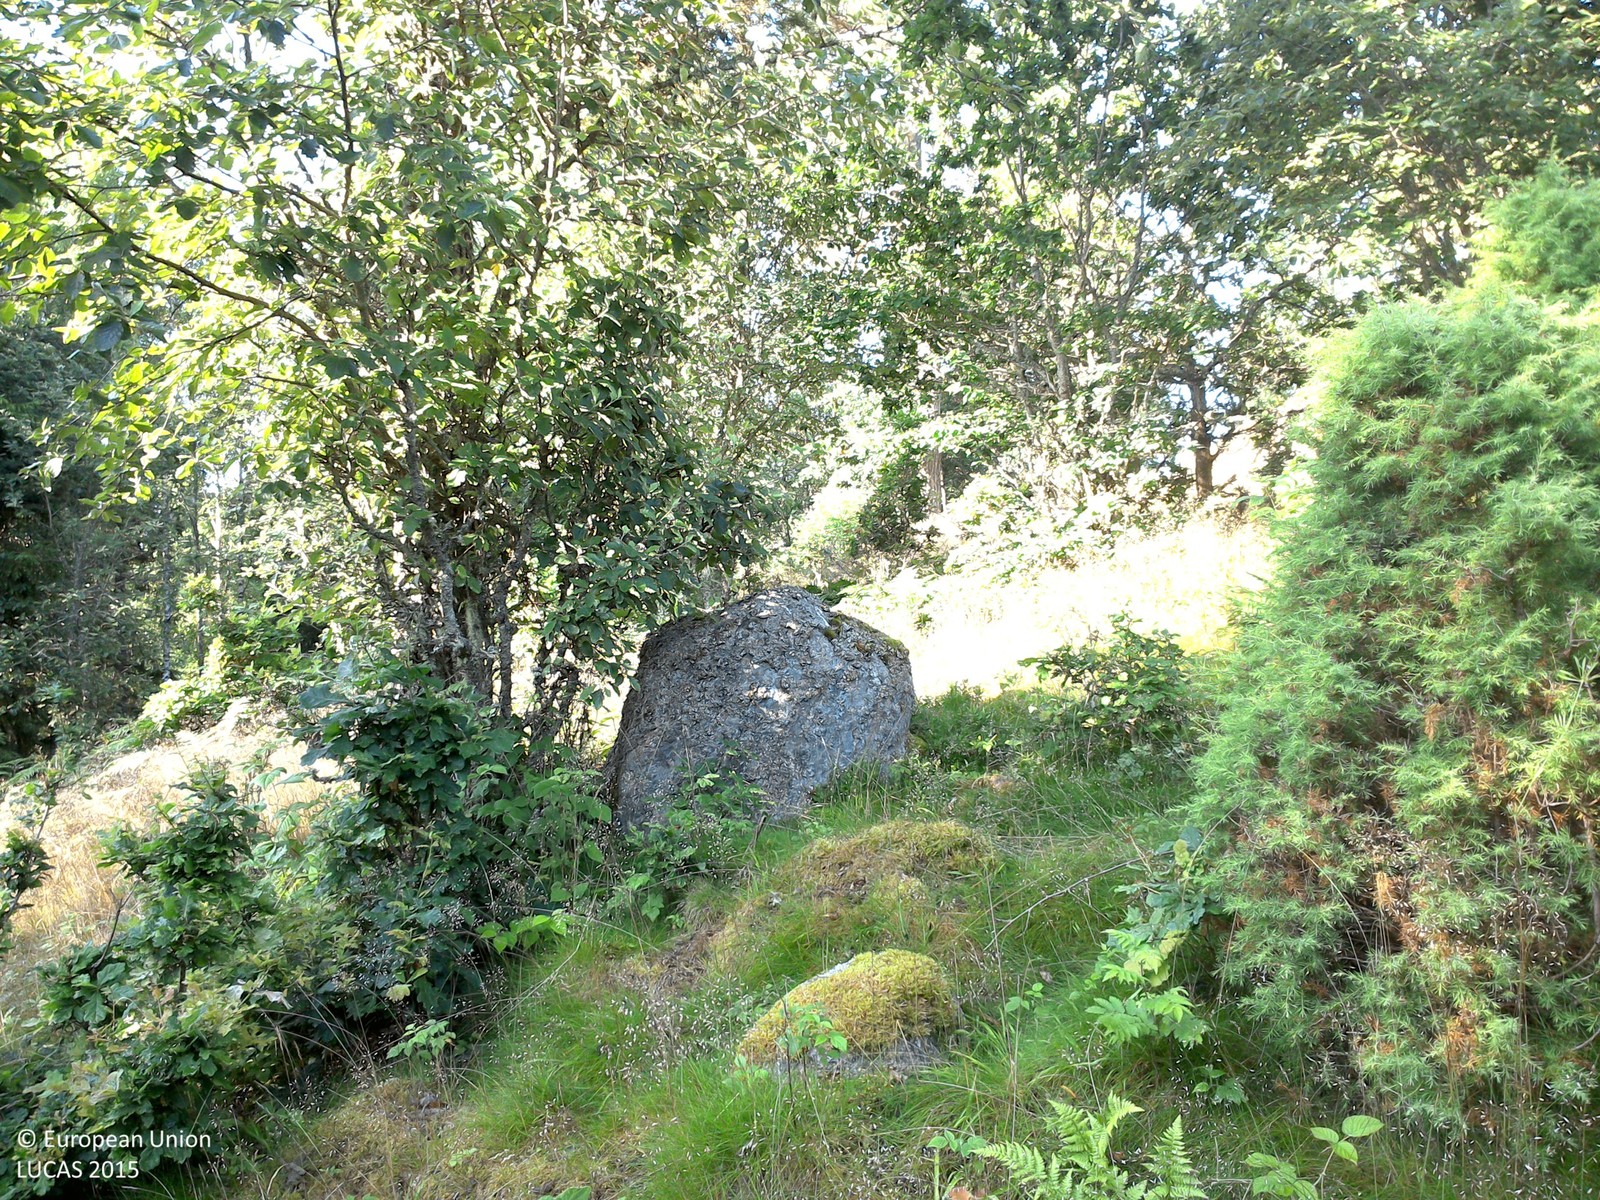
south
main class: Woodland
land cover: Broadleaved woodland
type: boreal forest
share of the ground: 25 - 50 %
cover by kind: herbaceous plants 75 %, broadleaved forest trees 20 %, shrubs 5 %
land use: Forestry
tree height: > 5 m
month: July
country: SE
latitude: 58.0393
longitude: 14.9237
